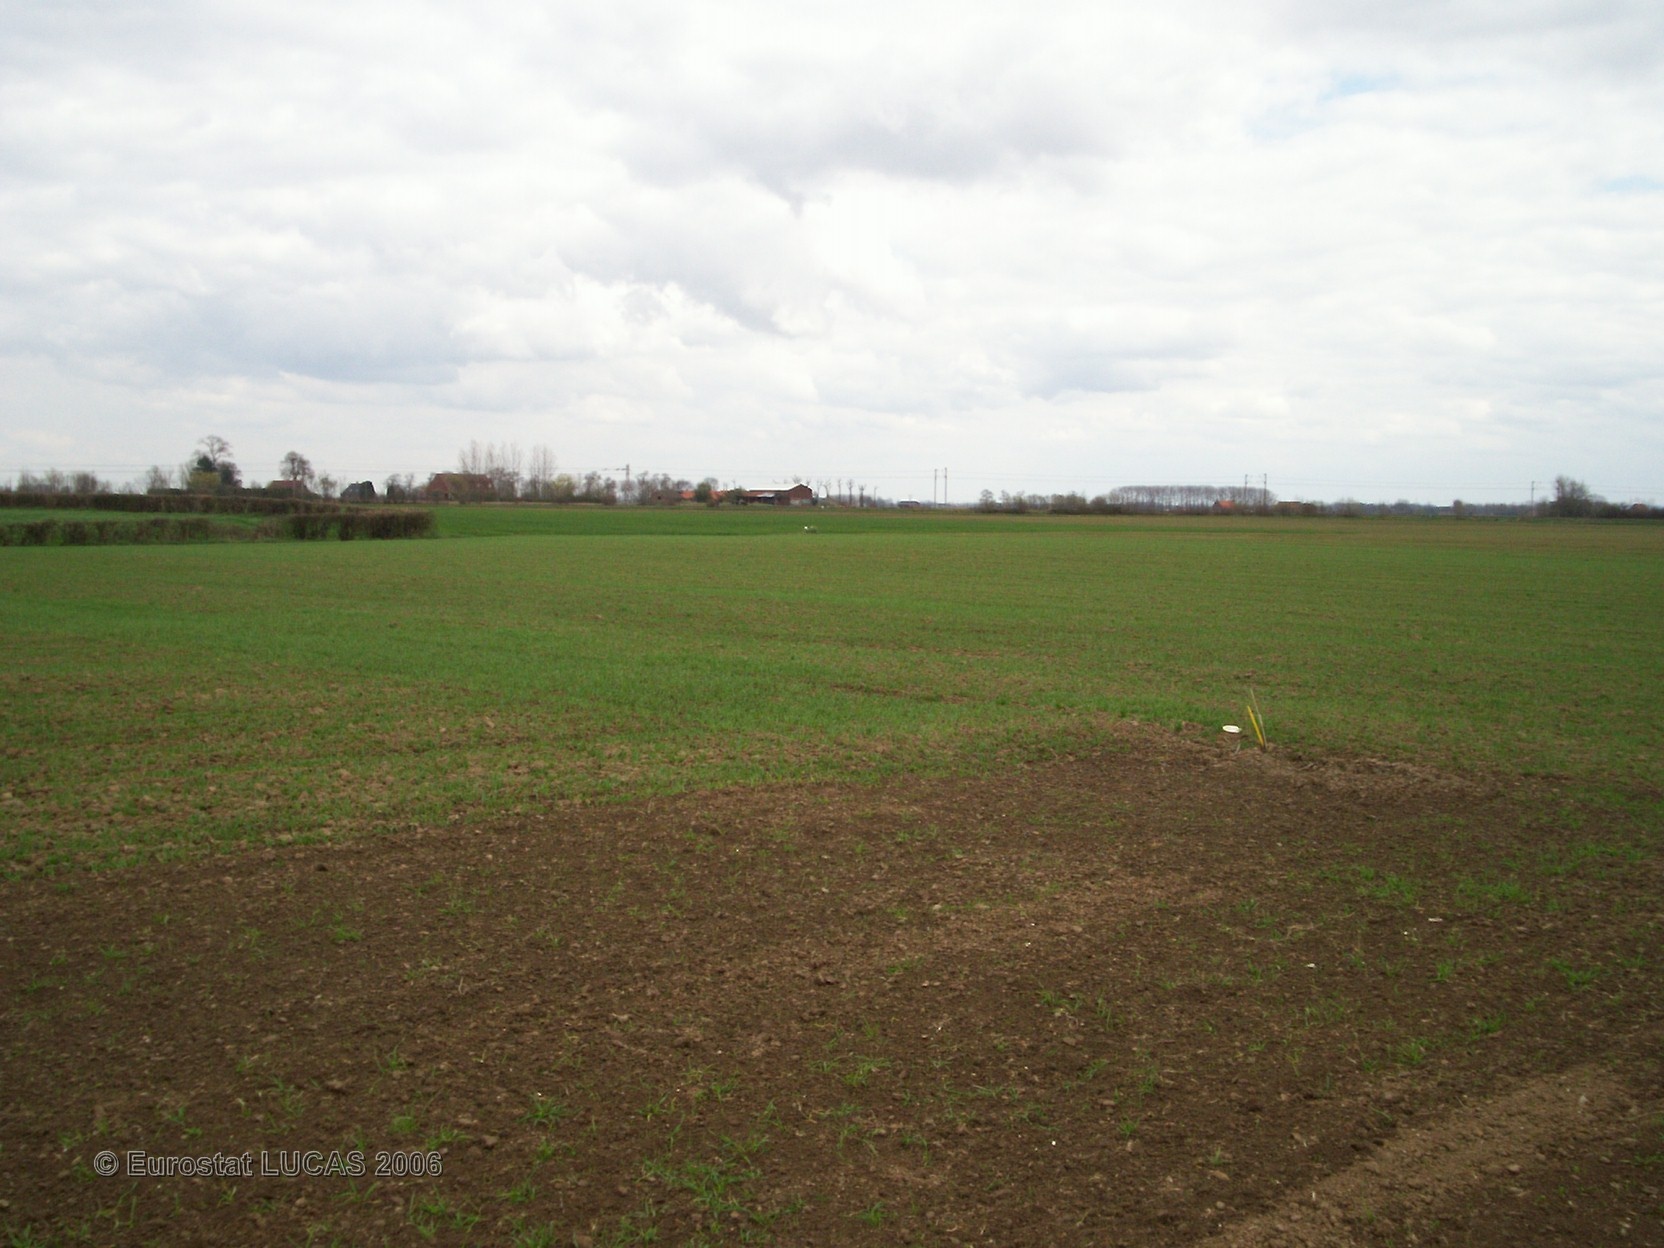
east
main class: Cropland
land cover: Common wheat
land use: Agriculture (excluding fallow land and kitchen gardens)
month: April
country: FR
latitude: 50.9062
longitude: 2.4069
